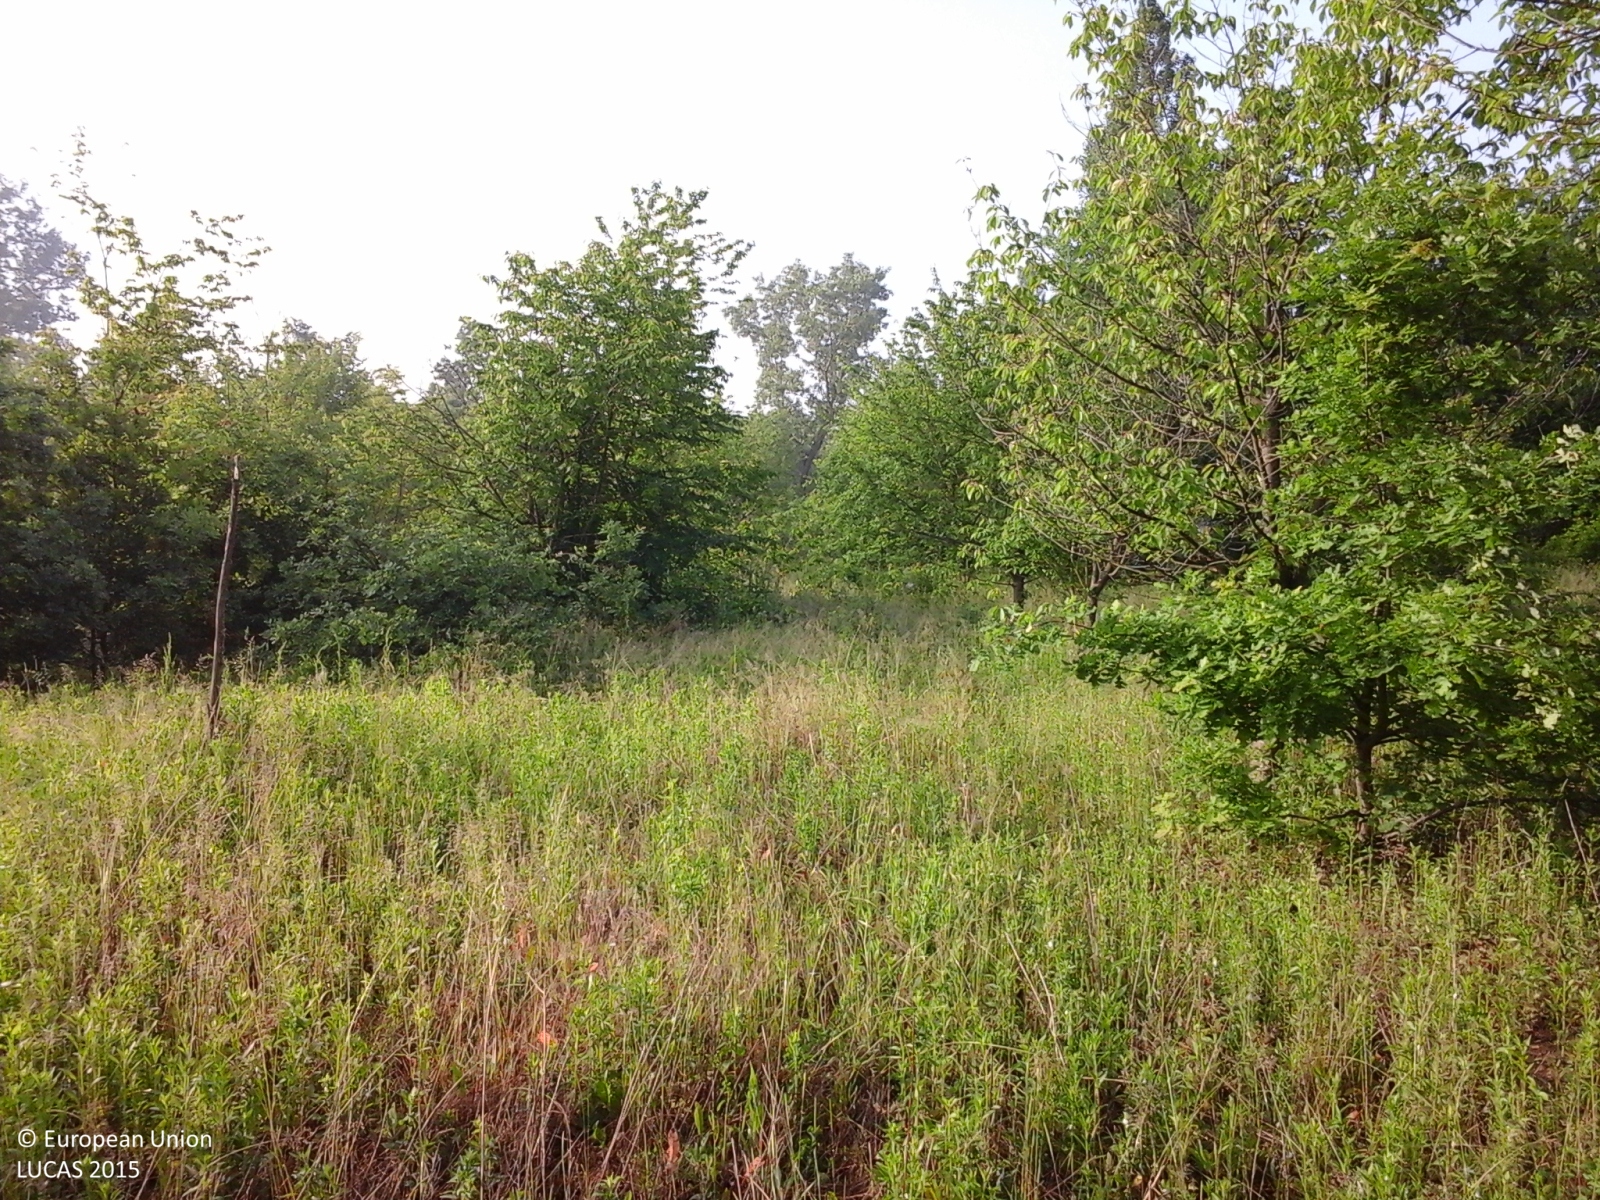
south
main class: Cropland
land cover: Cherry fruit
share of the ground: 10 - 25 %
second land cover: Spontaneously vegetated surfaces
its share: > 75 %
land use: Abandoned areas
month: May
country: IT
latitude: 44.9341
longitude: 8.4444
